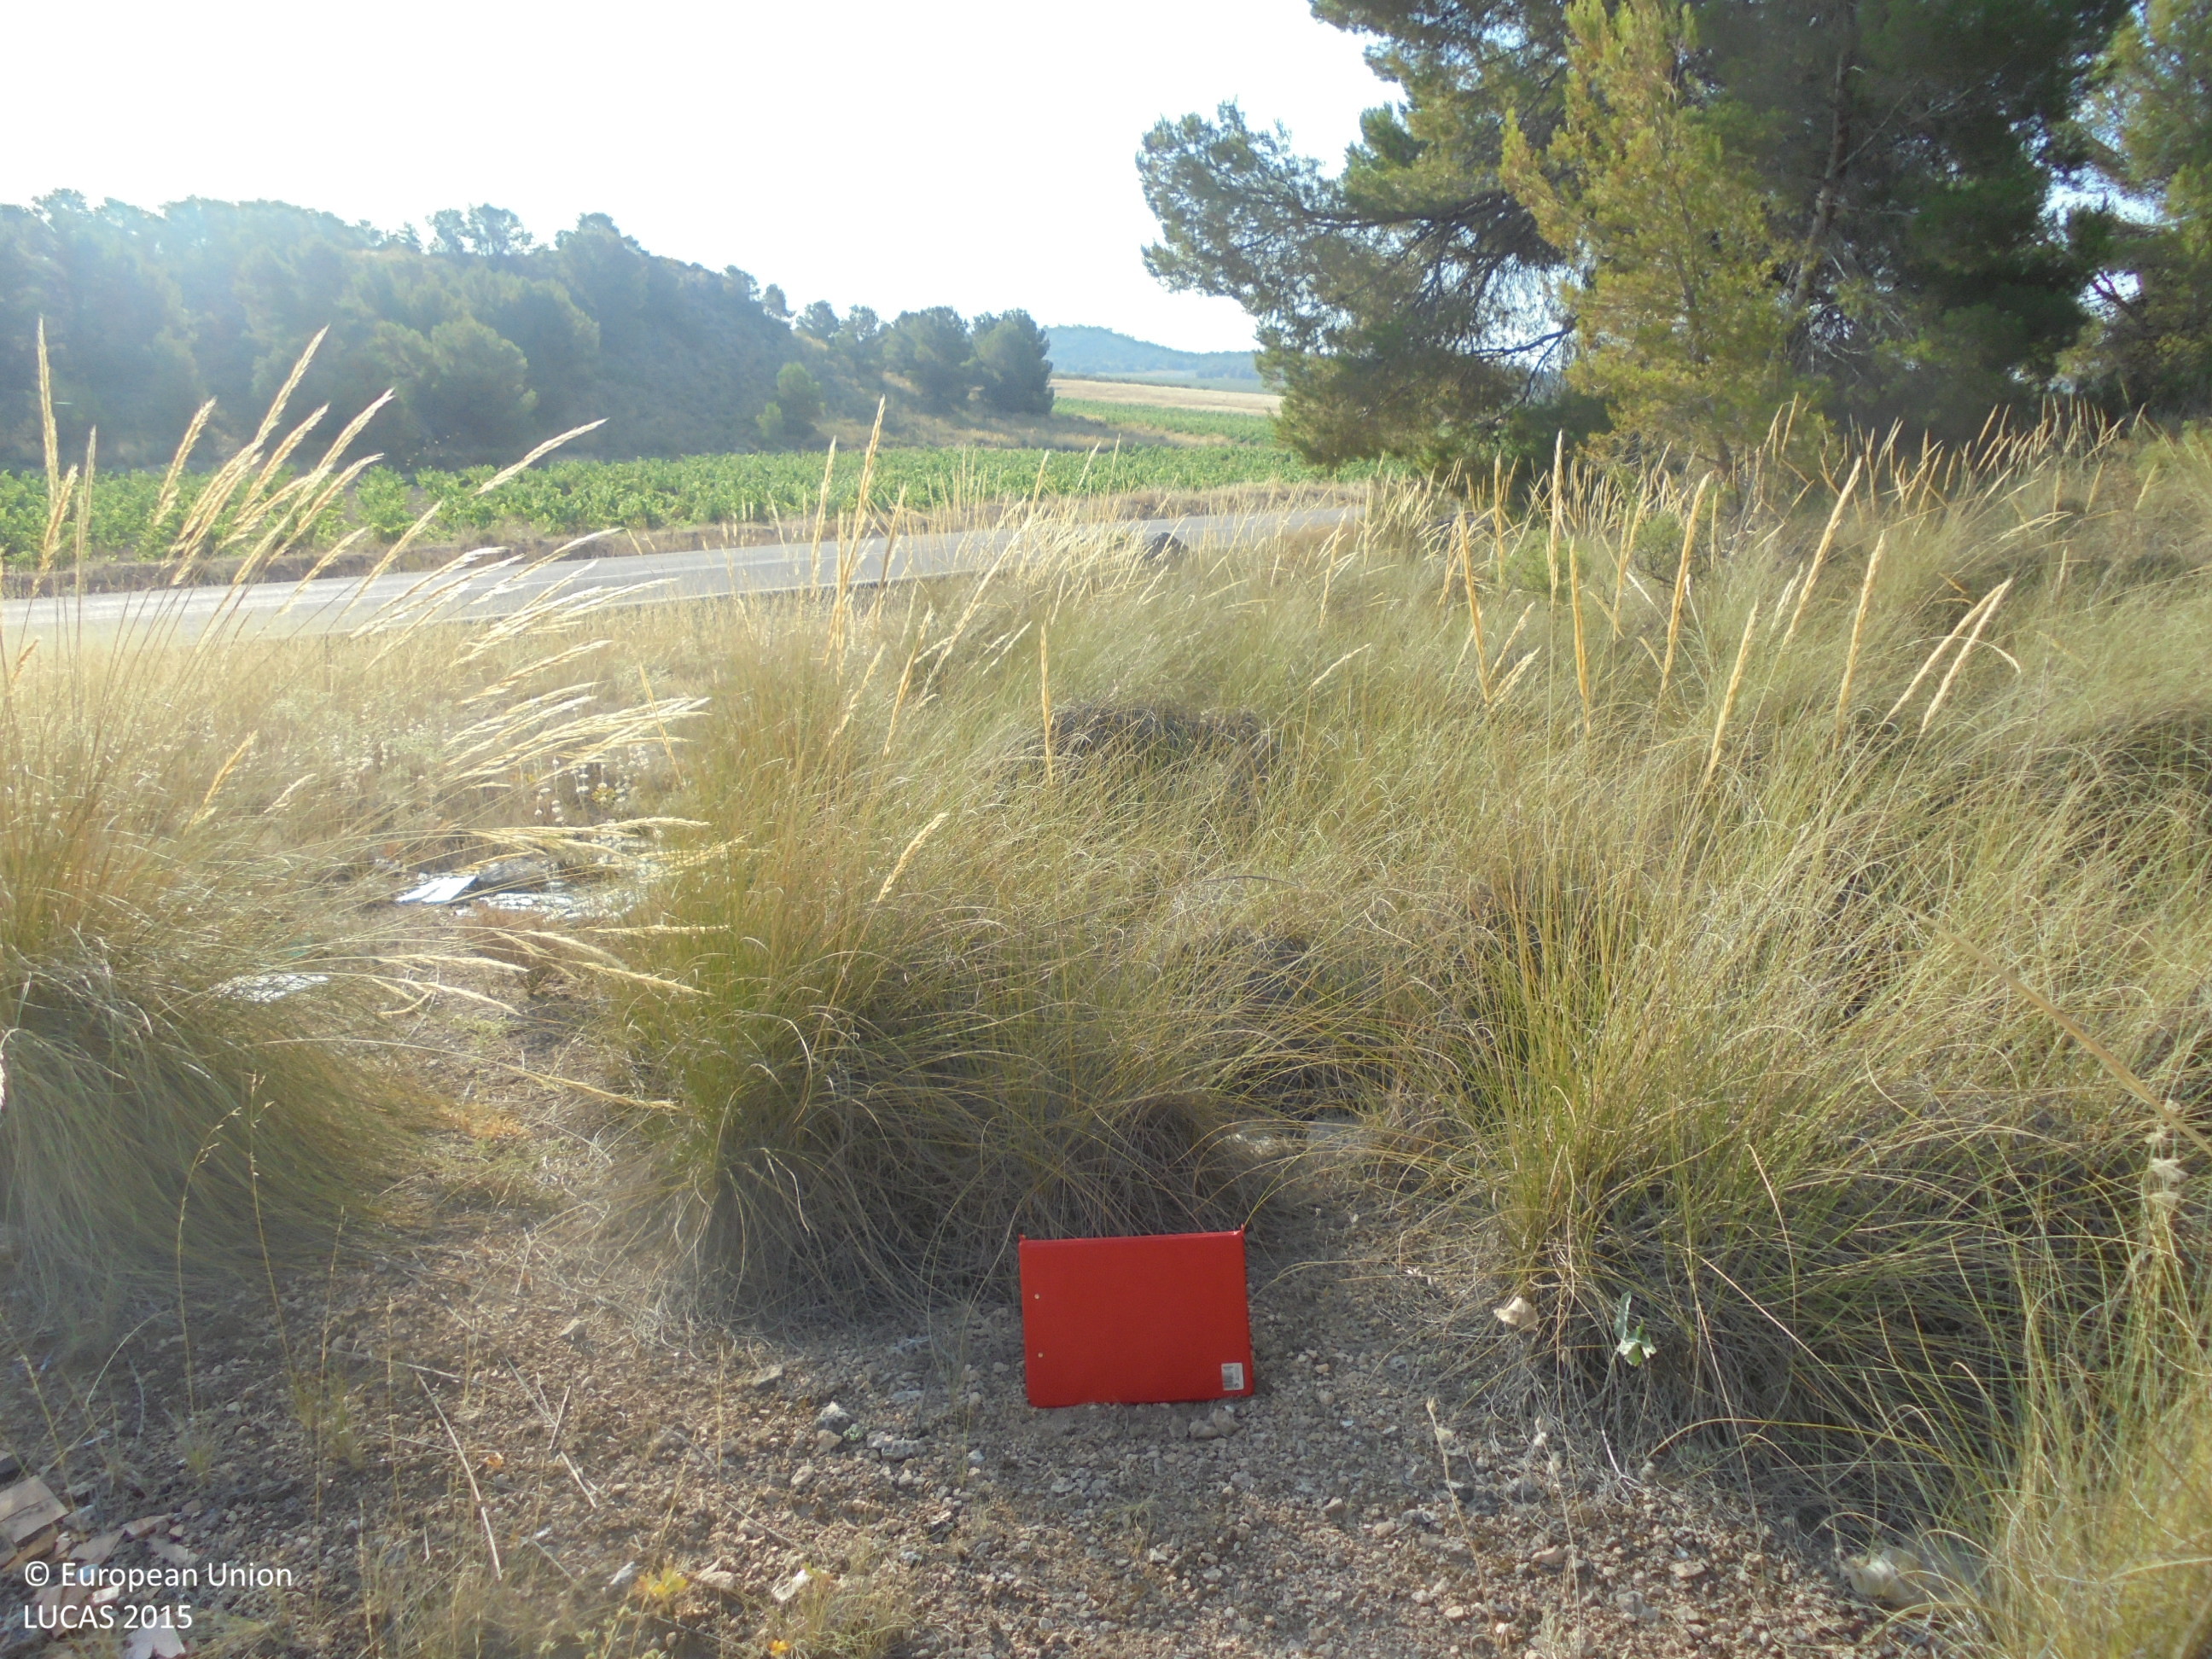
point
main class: Woodland
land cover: Pine dominated coniferous woodland
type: coniferous forest of the mediterranean region
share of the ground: 25 - 50 %
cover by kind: coniferous forest trees 45 %, shrubs 40 %, unconsolidated bare surface 15 %
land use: Semi-natural and natural areas not in use
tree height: > 5 m
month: July
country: ES
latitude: 38.5293
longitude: -1.4978
